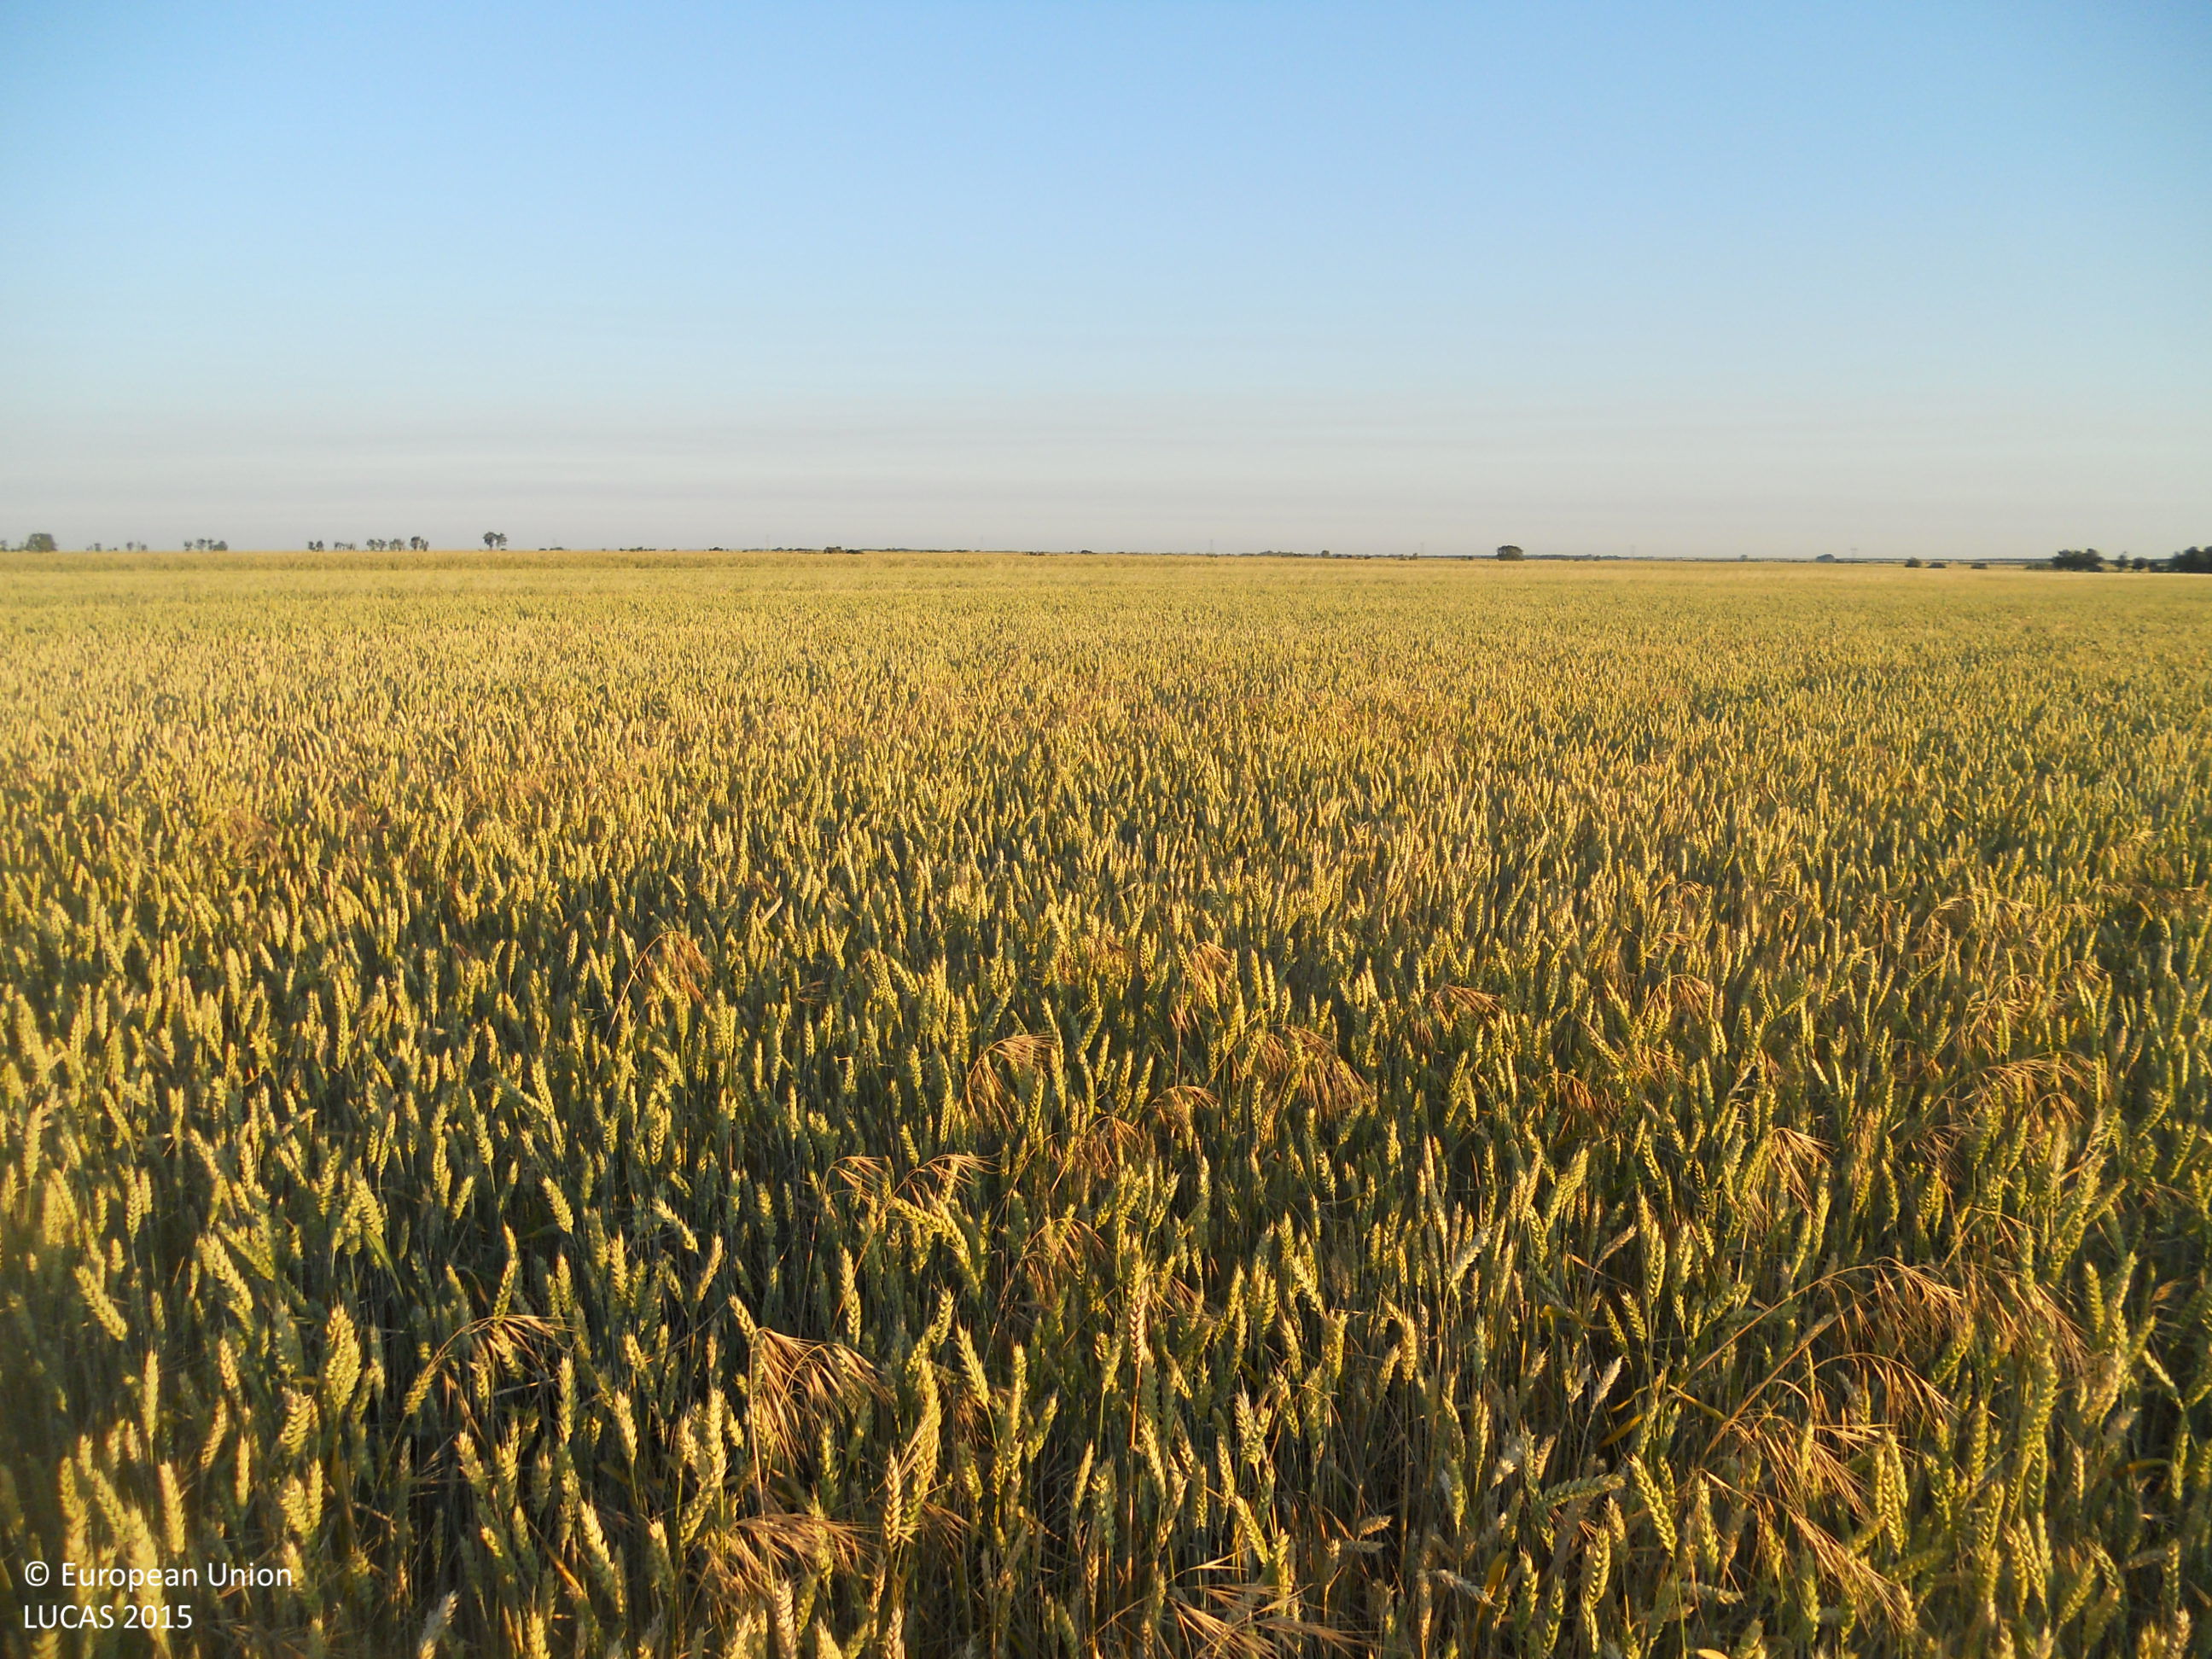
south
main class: Cropland
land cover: Common wheat
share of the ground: > 75 %
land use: Agriculture (excluding fallow land and kitchen gardens)
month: June
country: ES
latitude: 42.4747
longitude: -4.8108
